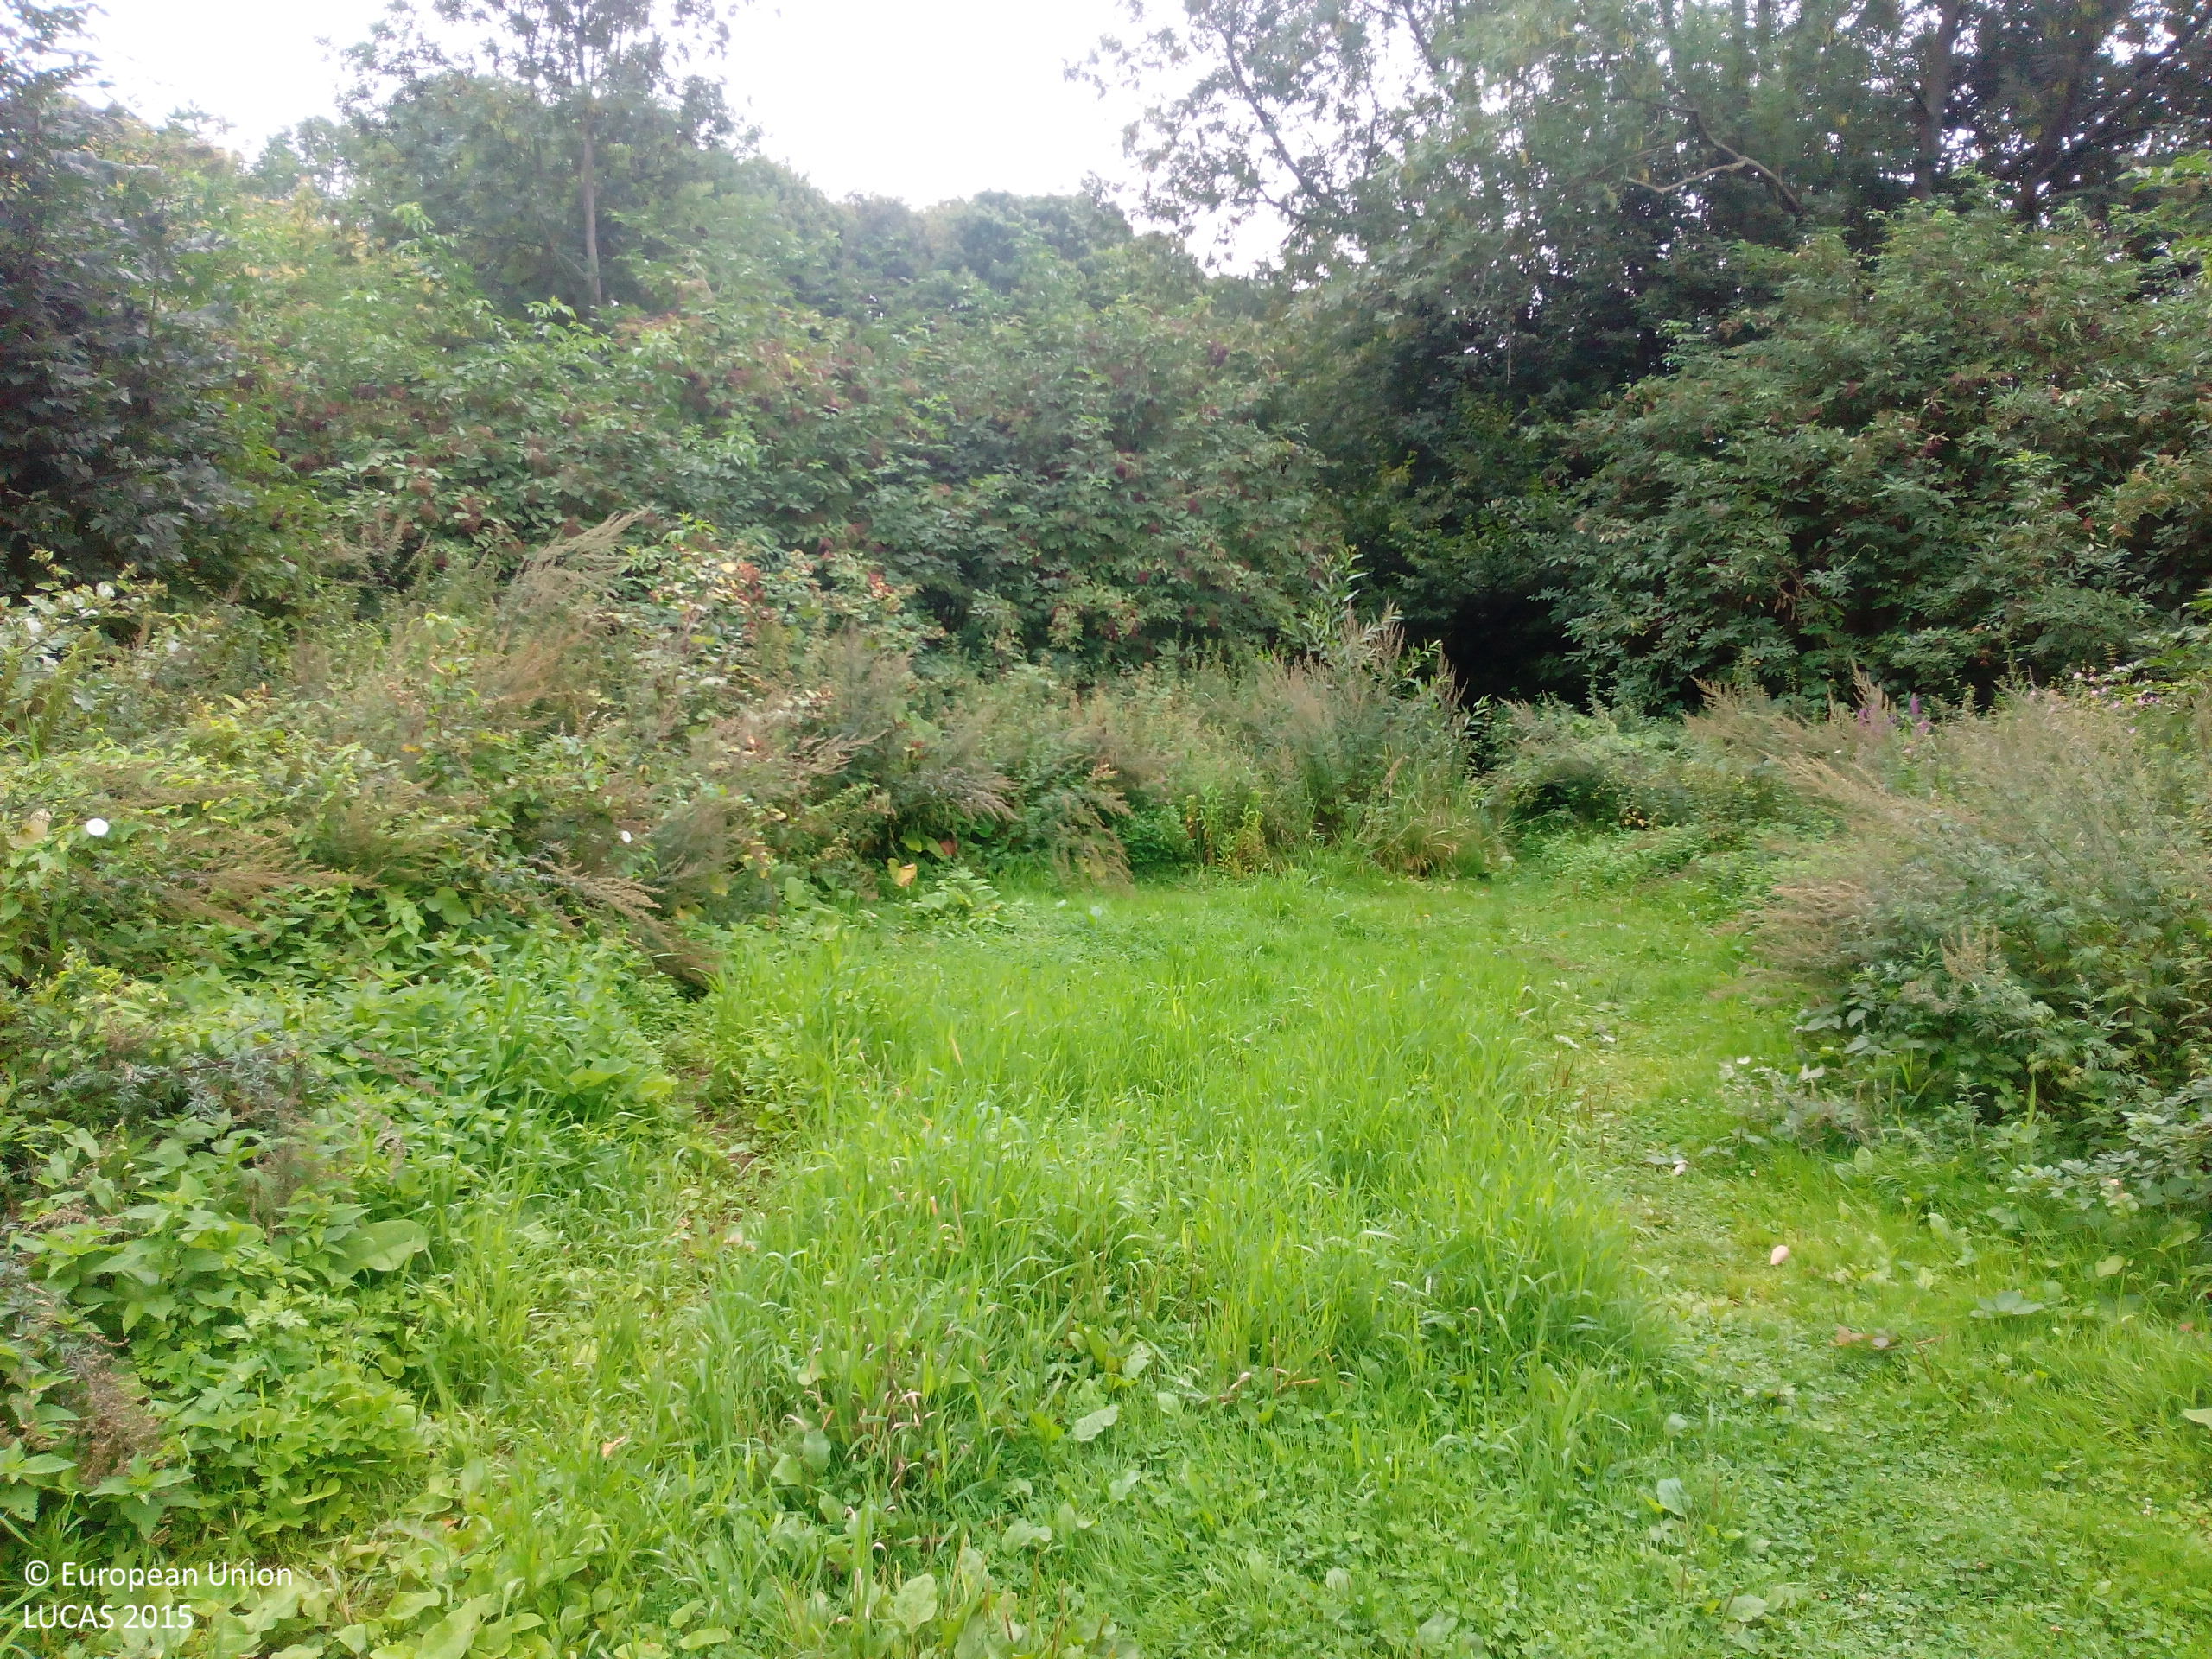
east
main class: Grassland
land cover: Spontaneously vegetated surfaces
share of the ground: > 75 %
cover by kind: herbaceous plants 95 %, shrubs 5 %
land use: Amenities, museums, leisure
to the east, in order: Spontaneously vegetated surfaces; Grassland without tree/shrub cover; Broadleaved woodland; Tracks; Dry stone walls; Broadleaved woodland; Artificial constructions in urban areas; Grassland with sparse tree/shrub cover; Broadleaved woodland
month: August
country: DE
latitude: 53.5457
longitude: 9.9246
